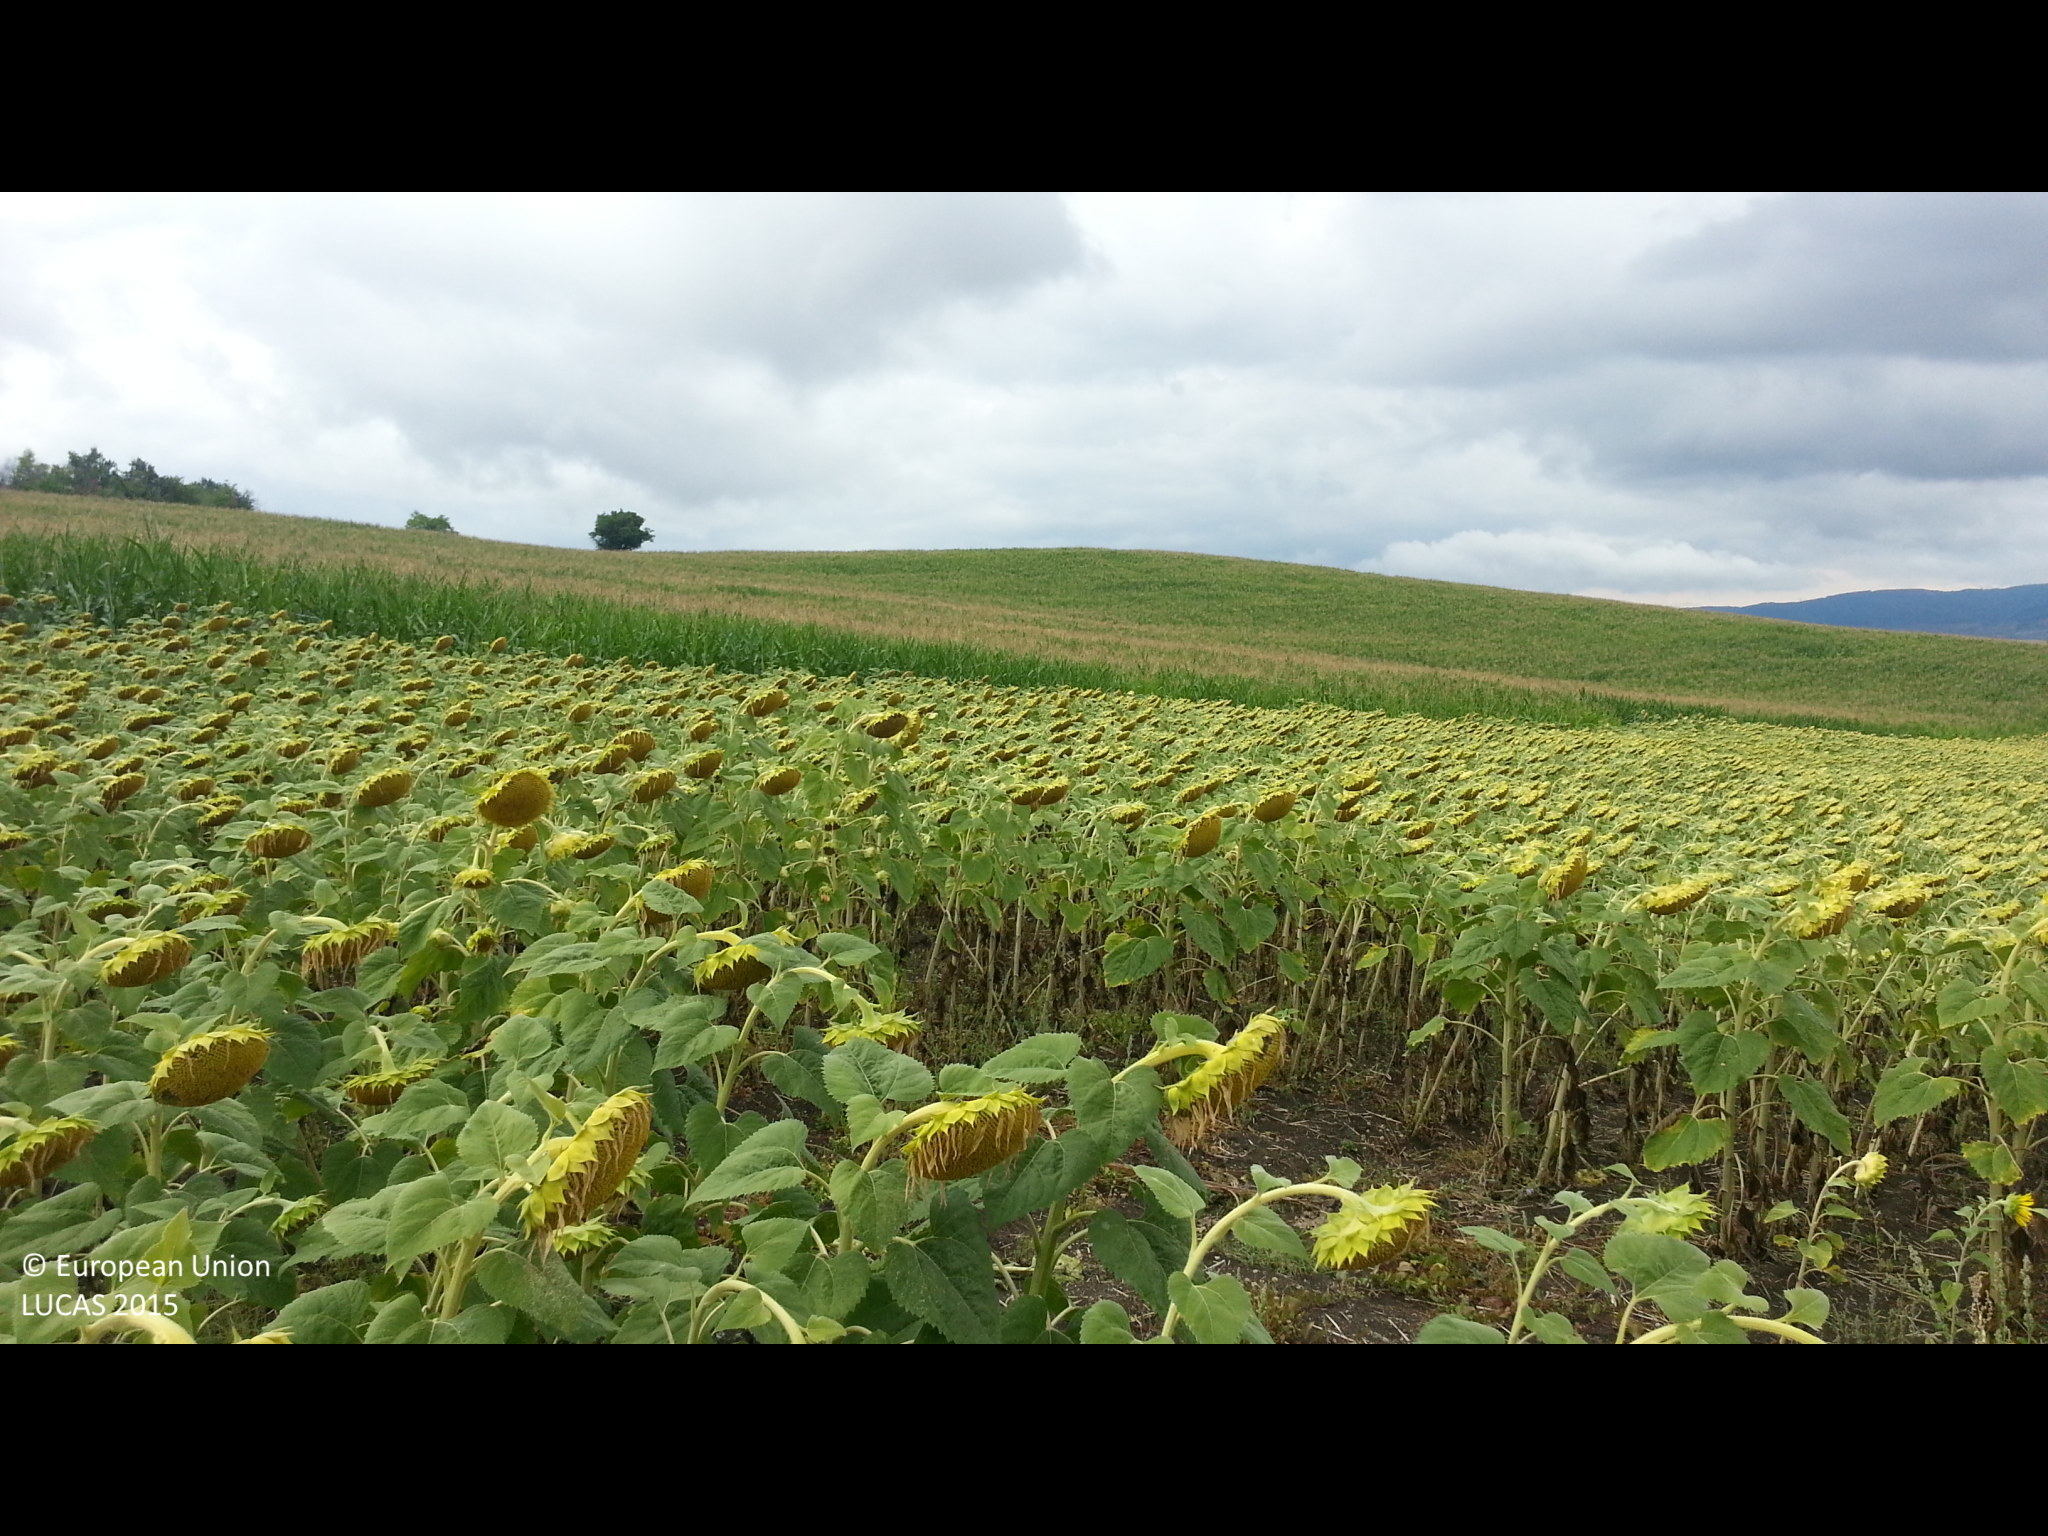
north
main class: Cropland
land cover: Sunflower
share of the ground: > 75 %
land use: Agriculture (excluding fallow land and kitchen gardens)
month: August
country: BG
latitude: 42.3094
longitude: 22.9701
